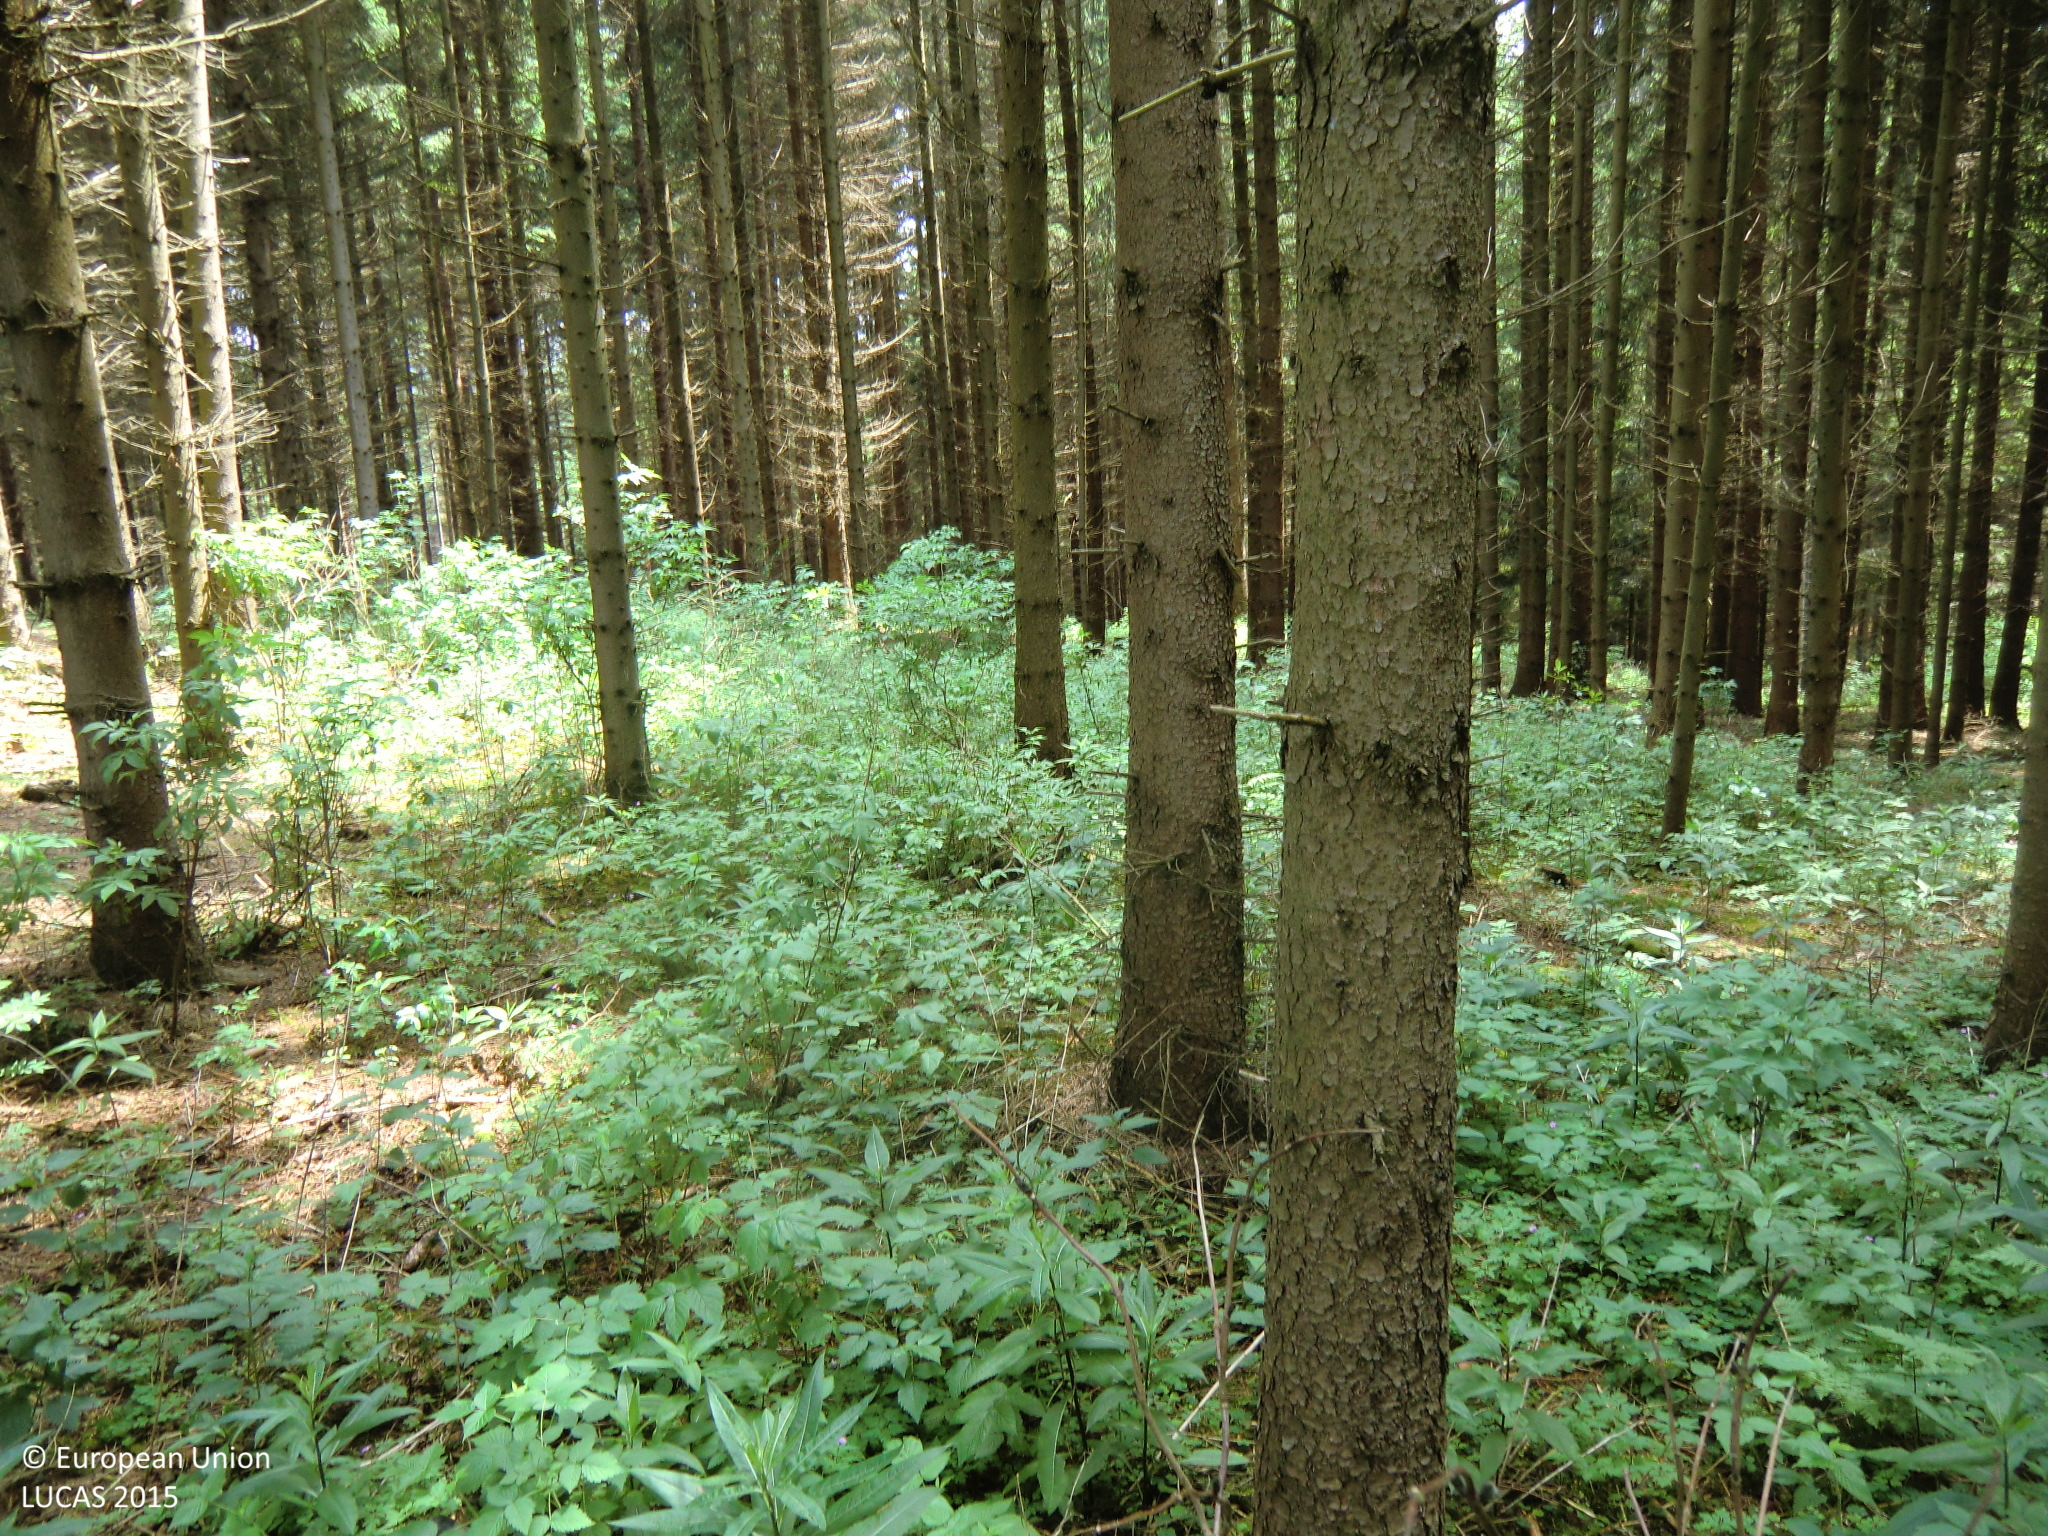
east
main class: Woodland
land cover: Spruce dominated coniferous woodland
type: hemiboreal forest and nemoral coniferous forest and mixed broadleaved-coniferous forest
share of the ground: > 75 %
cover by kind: coniferous forest trees 90 %, herbaceous plants 10 %
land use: Forestry
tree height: > 5 m
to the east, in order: Spruce dominated coniferous woodland; Tracks; Spruce dominated coniferous woodland; Rivers and streams; Spruce dominated coniferous woodland; Paved roads, cycling and walking lanes; Spruce dominated coniferous woodland; Tracks; Spruce dominated coniferous woodland
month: June
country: AT
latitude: 48.6206
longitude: 14.8717
